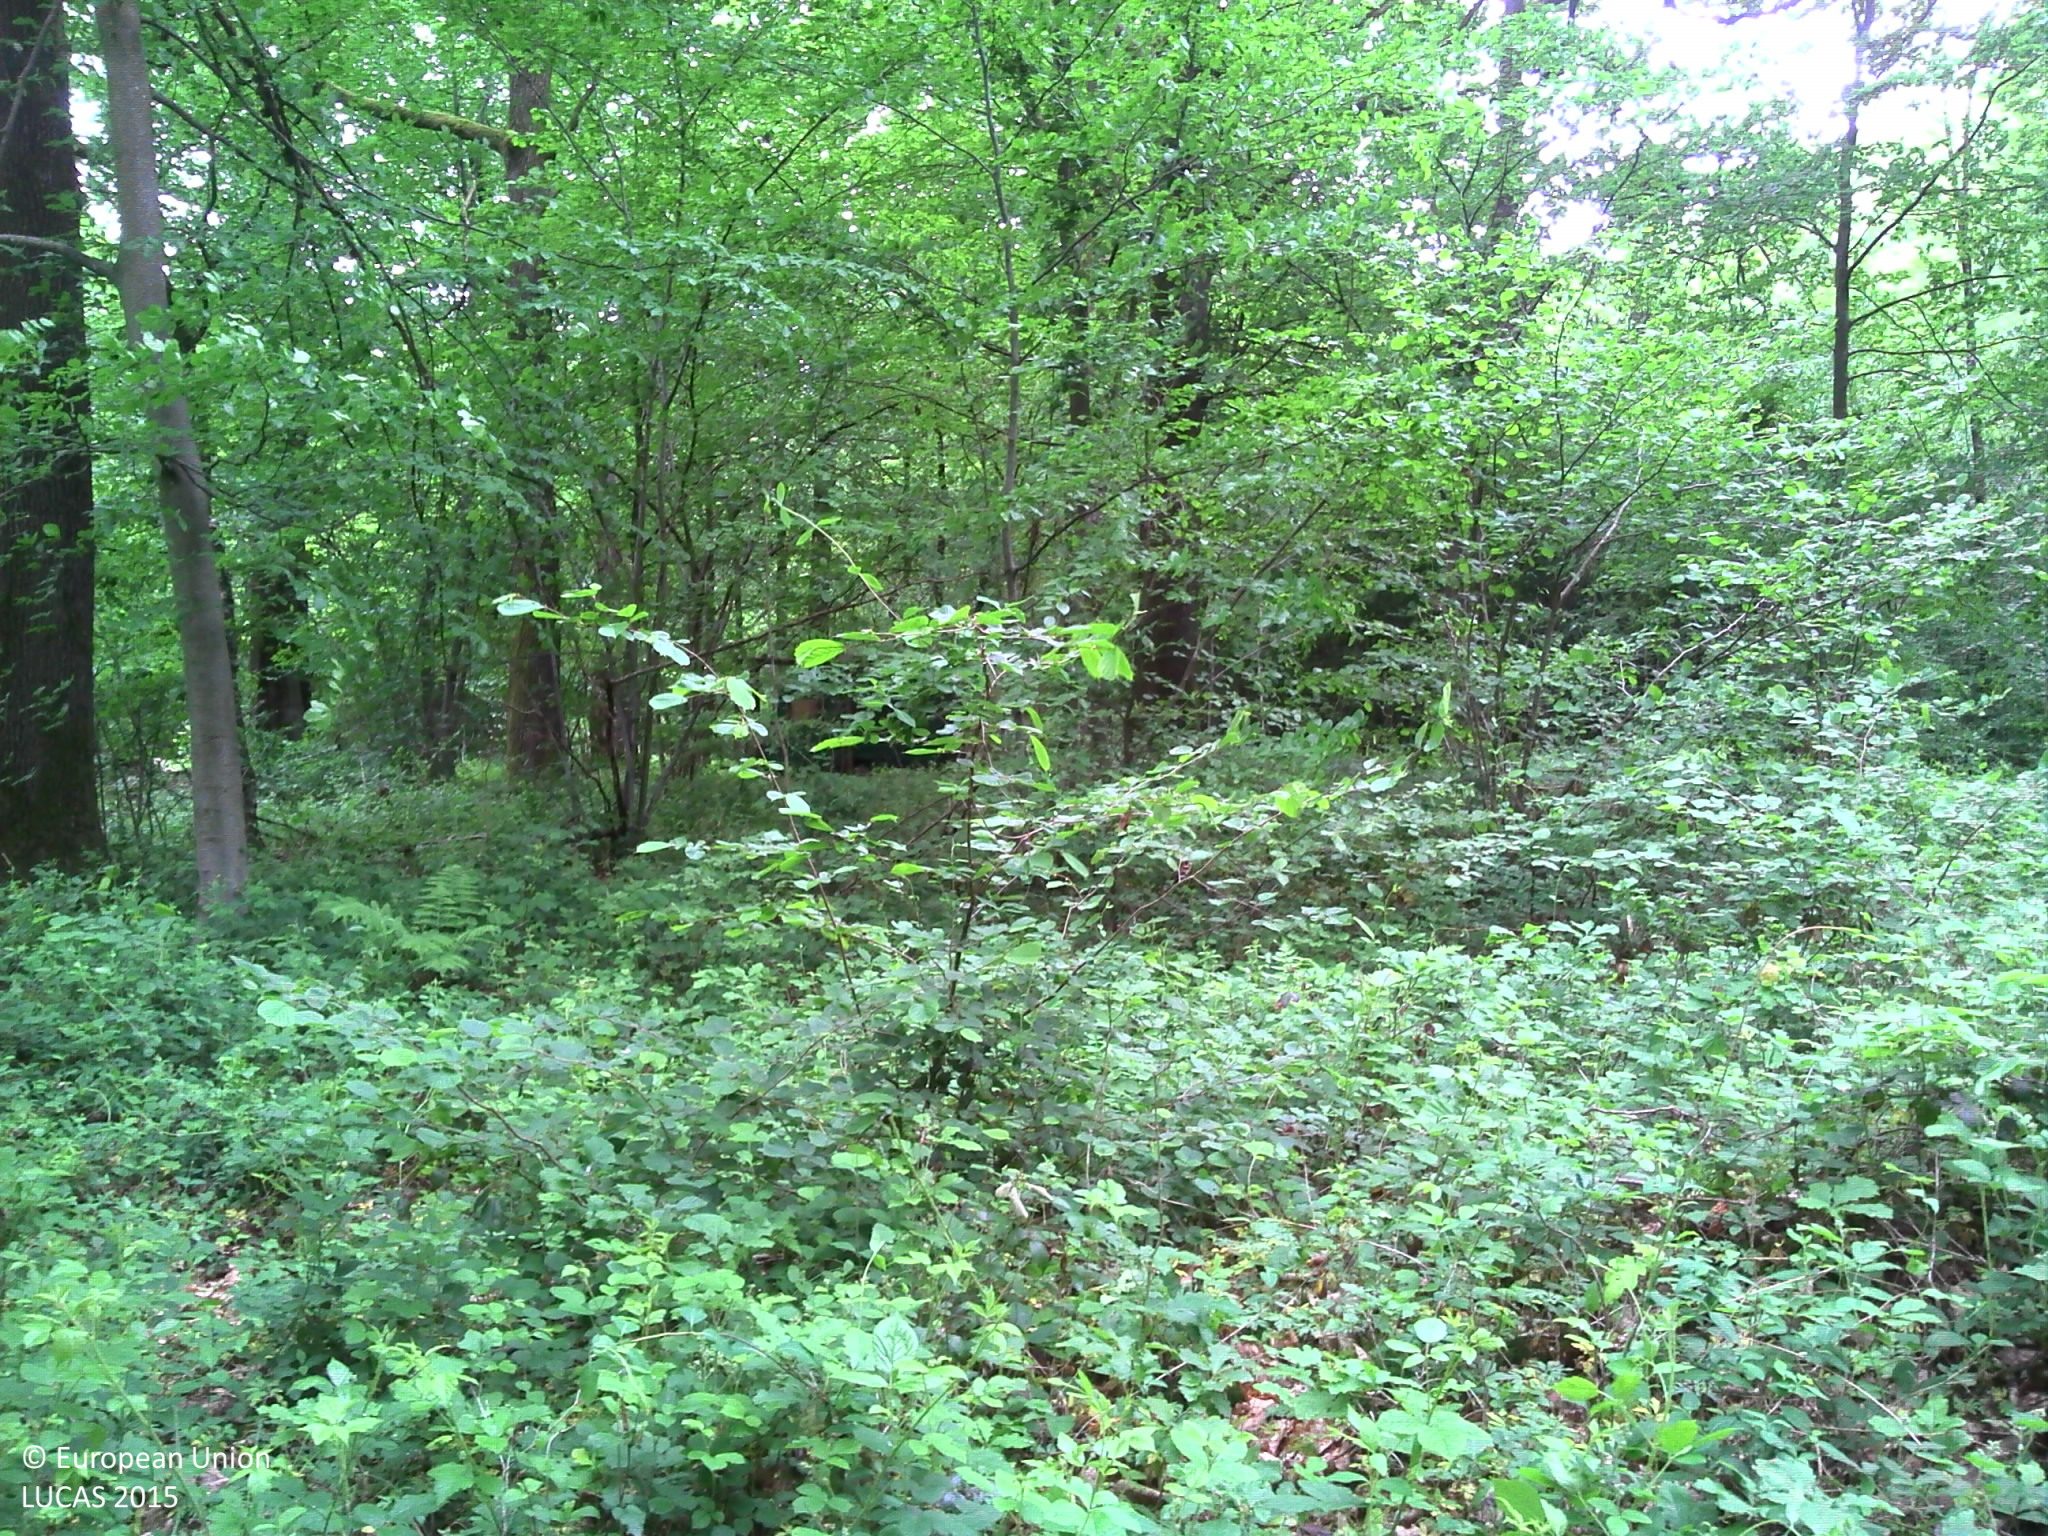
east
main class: Woodland
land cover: Broadleaved woodland
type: acidophilous oak and oak-birch forest
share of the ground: > 75 %
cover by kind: broadleaved forest trees 85 %, herbaceous plants 15 %
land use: Forestry
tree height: > 5 m
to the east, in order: Broadleaved woodland; Tracks; Broadleaved woodland
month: June
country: BE
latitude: 50.4053
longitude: 5.5944
